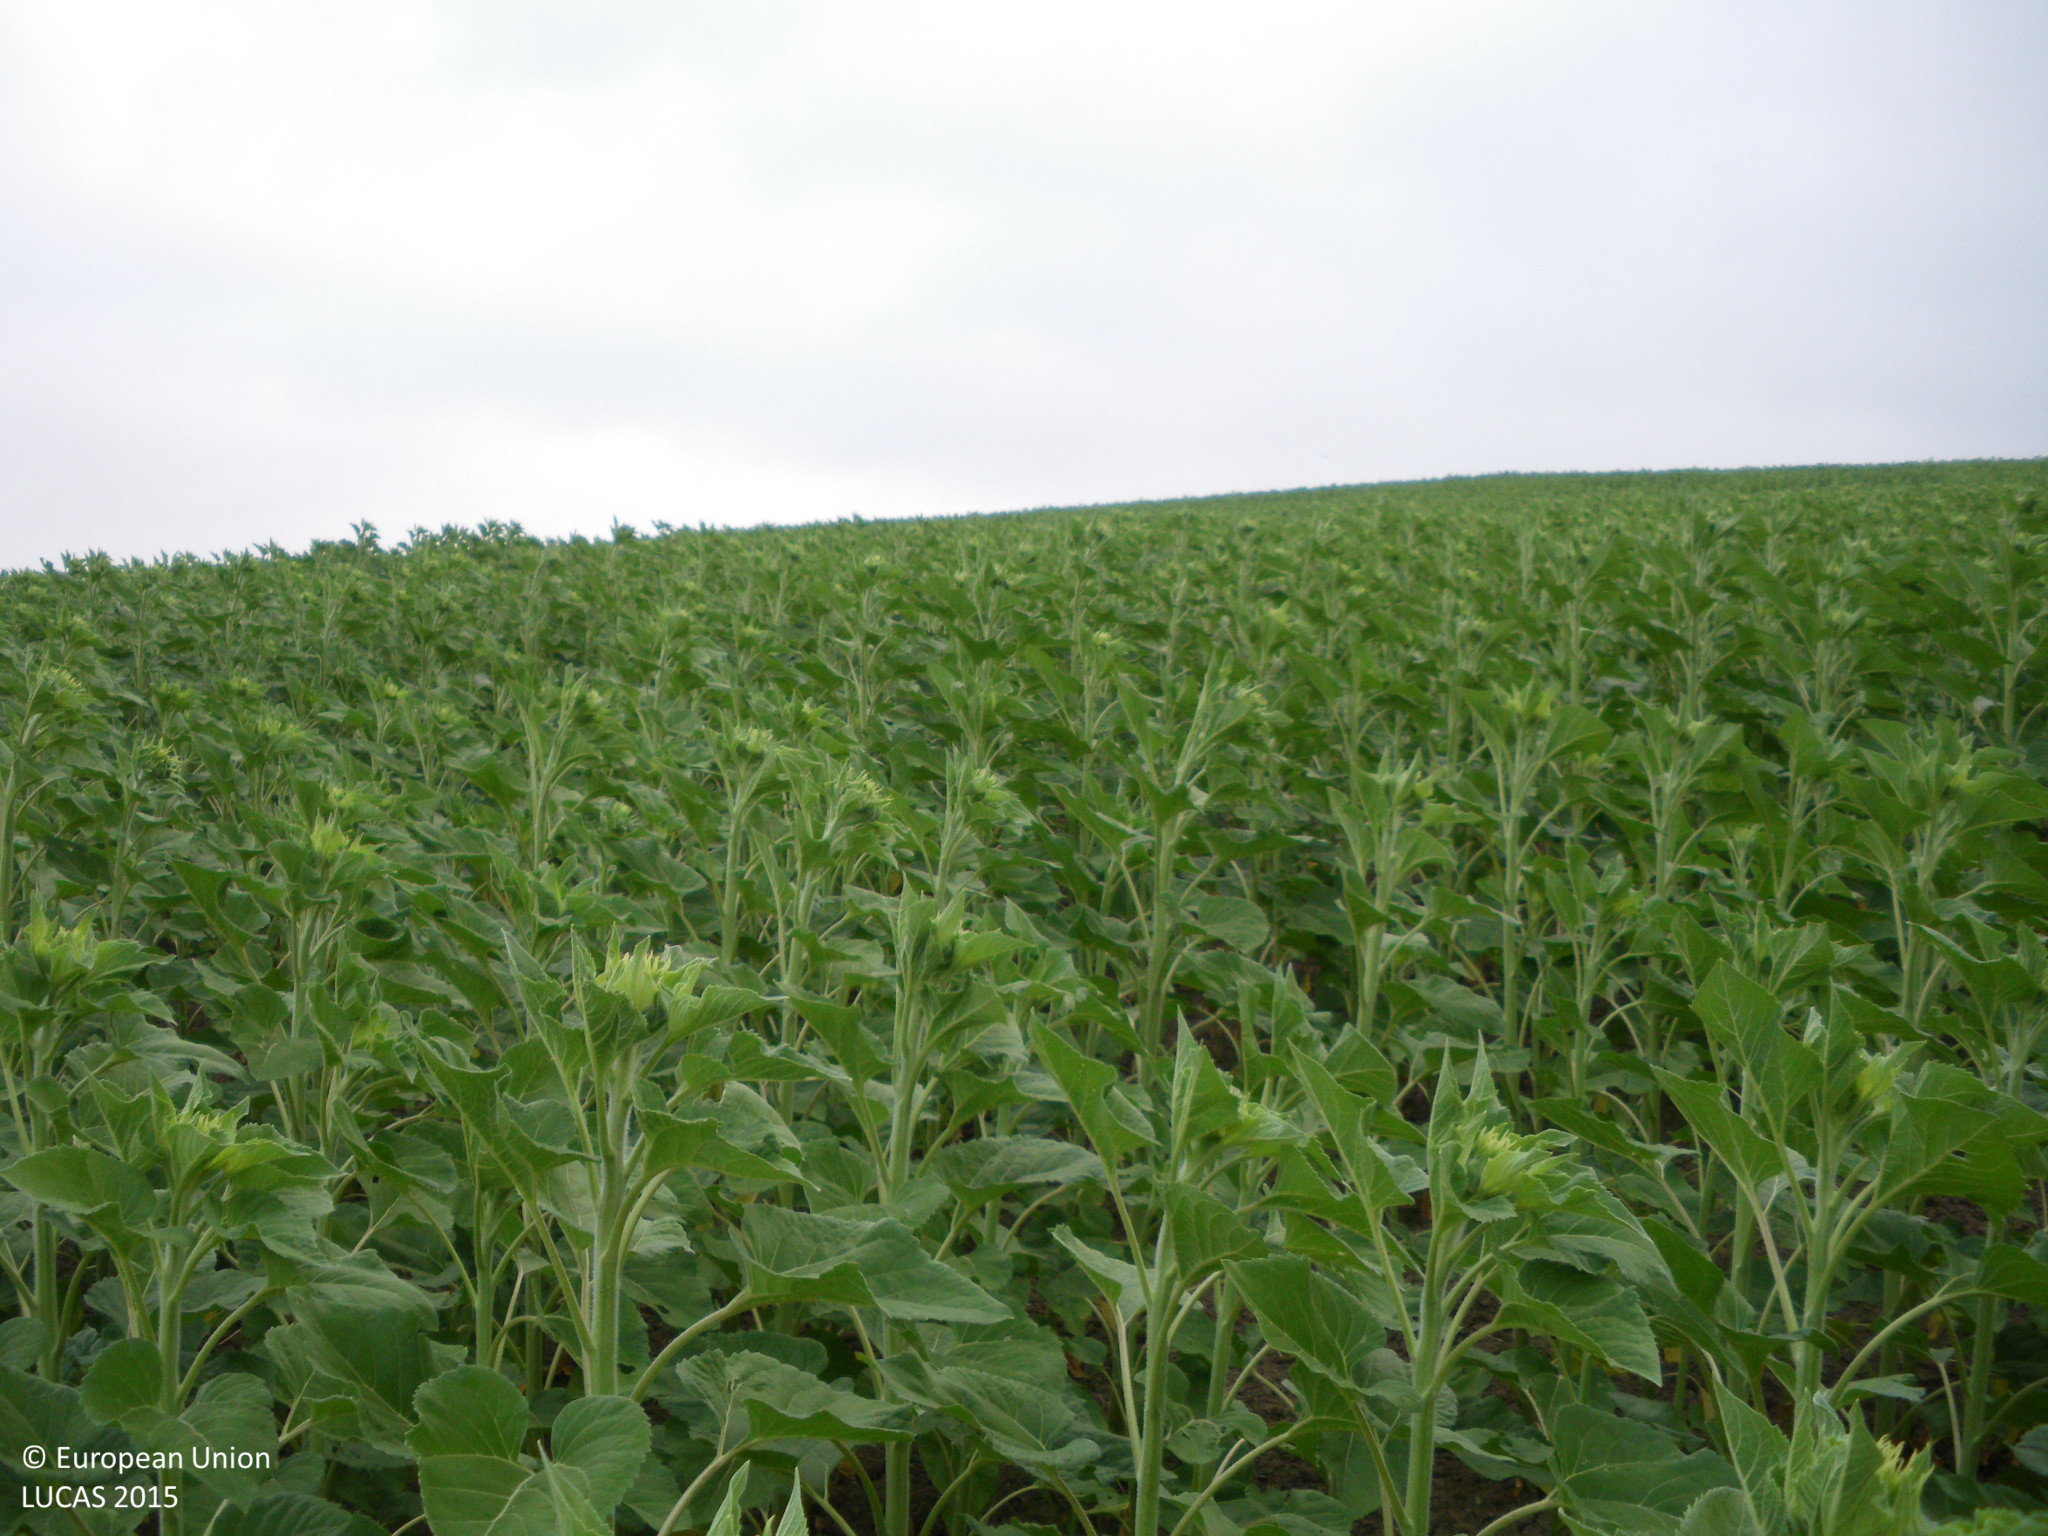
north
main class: Cropland
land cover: Sunflower
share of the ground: > 75 %
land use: Agriculture (excluding fallow land and kitchen gardens)
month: May
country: ES
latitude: 36.7088
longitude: -6.1441
